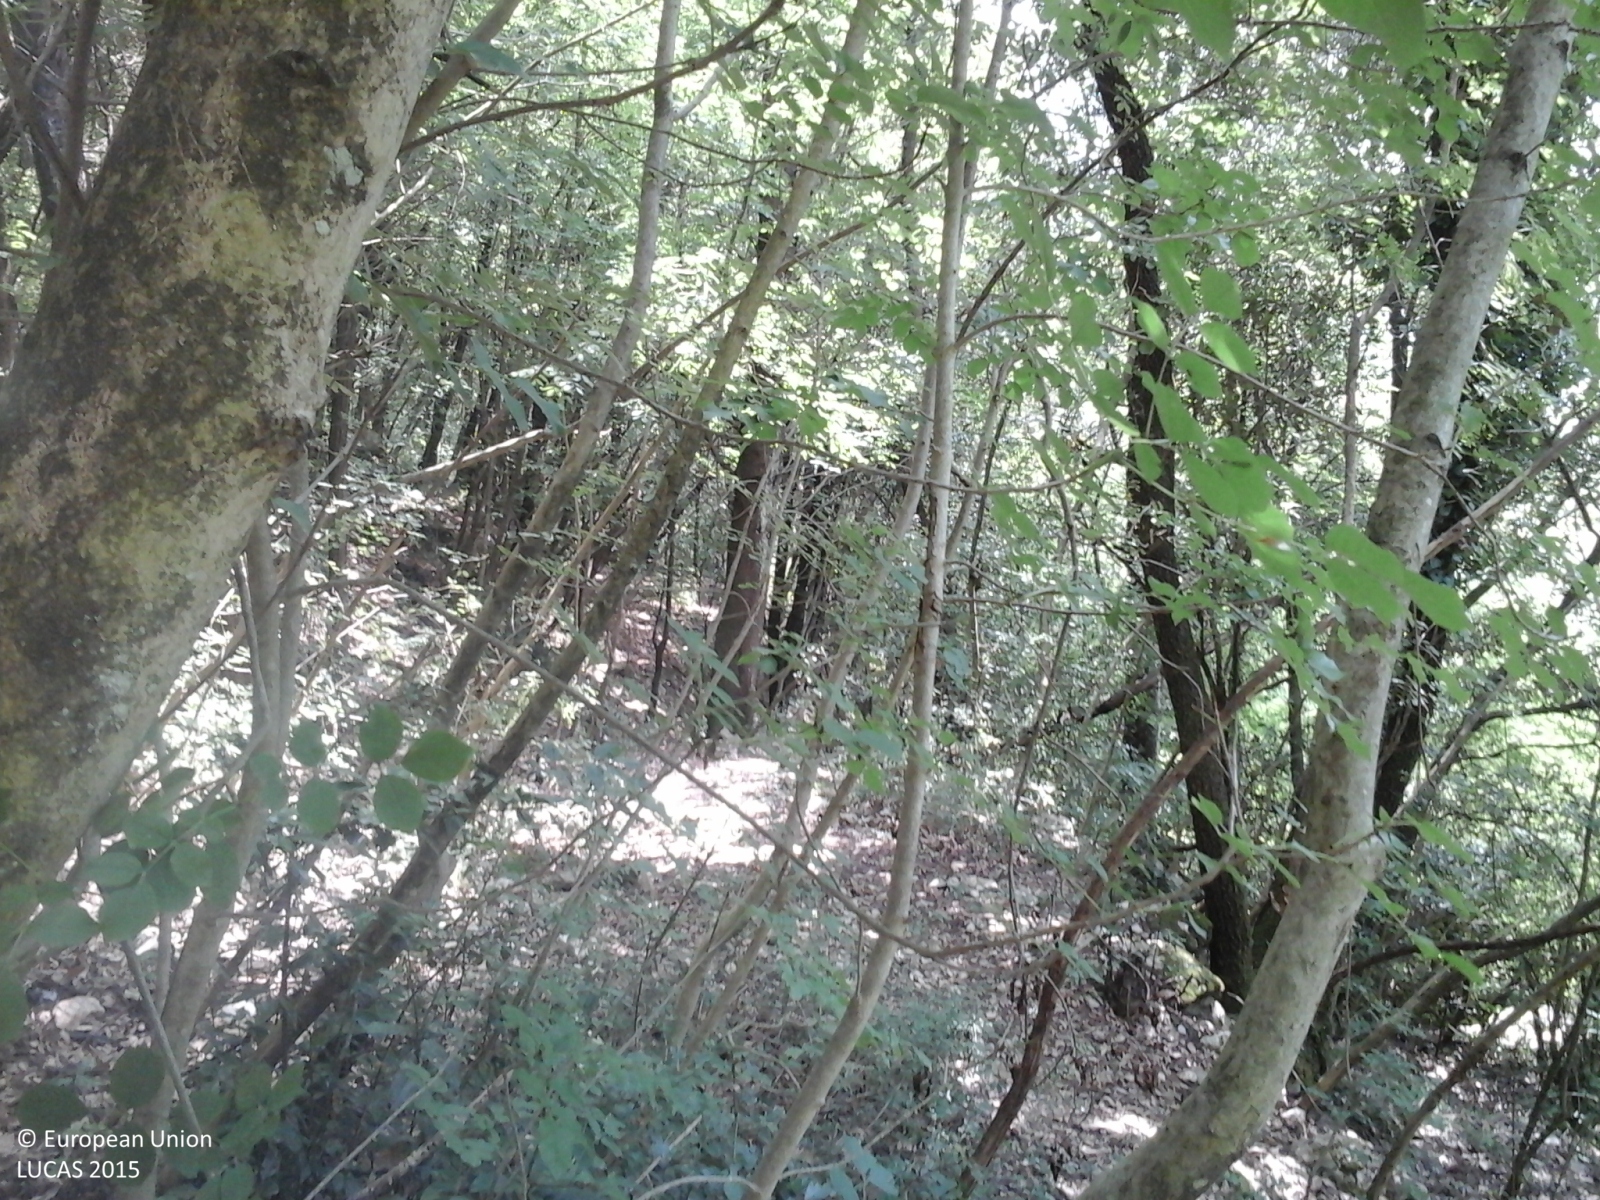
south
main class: Woodland
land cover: Other mixed woodland
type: thermophilous deciduous forest
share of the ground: > 75 %
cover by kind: broadleaved forest trees 75 %, coniferous forest trees 25 %
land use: Forestry
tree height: > 5 m
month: June
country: IT
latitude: 43.9303
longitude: 11.0561
